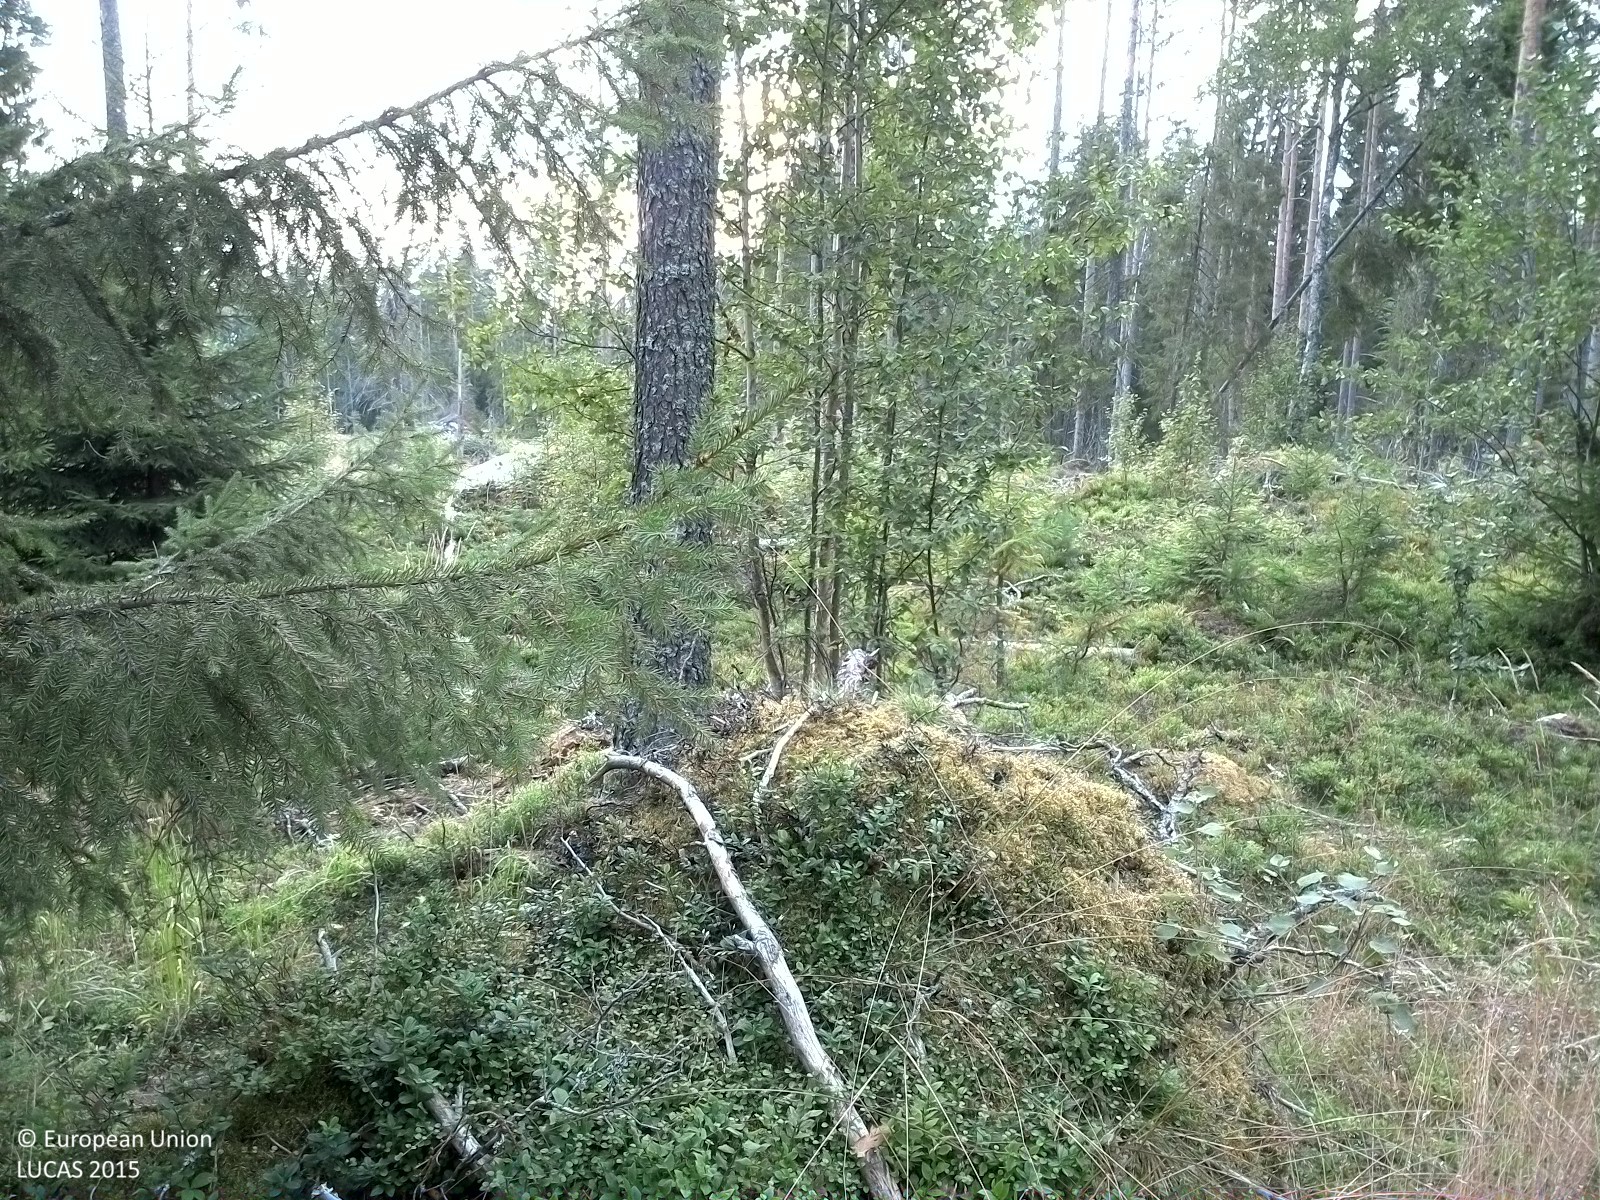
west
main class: Woodland
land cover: Pine dominated coniferous woodland
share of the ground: 50 - 75 %
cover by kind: coniferous forest trees 45 %, shrubs 20 %, herbaceous plants 20 %, broadleaved forest trees 10 %, lichens and mosses 5 %
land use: Forestry
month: August
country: SE
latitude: 62.4991
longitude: 16.2881
